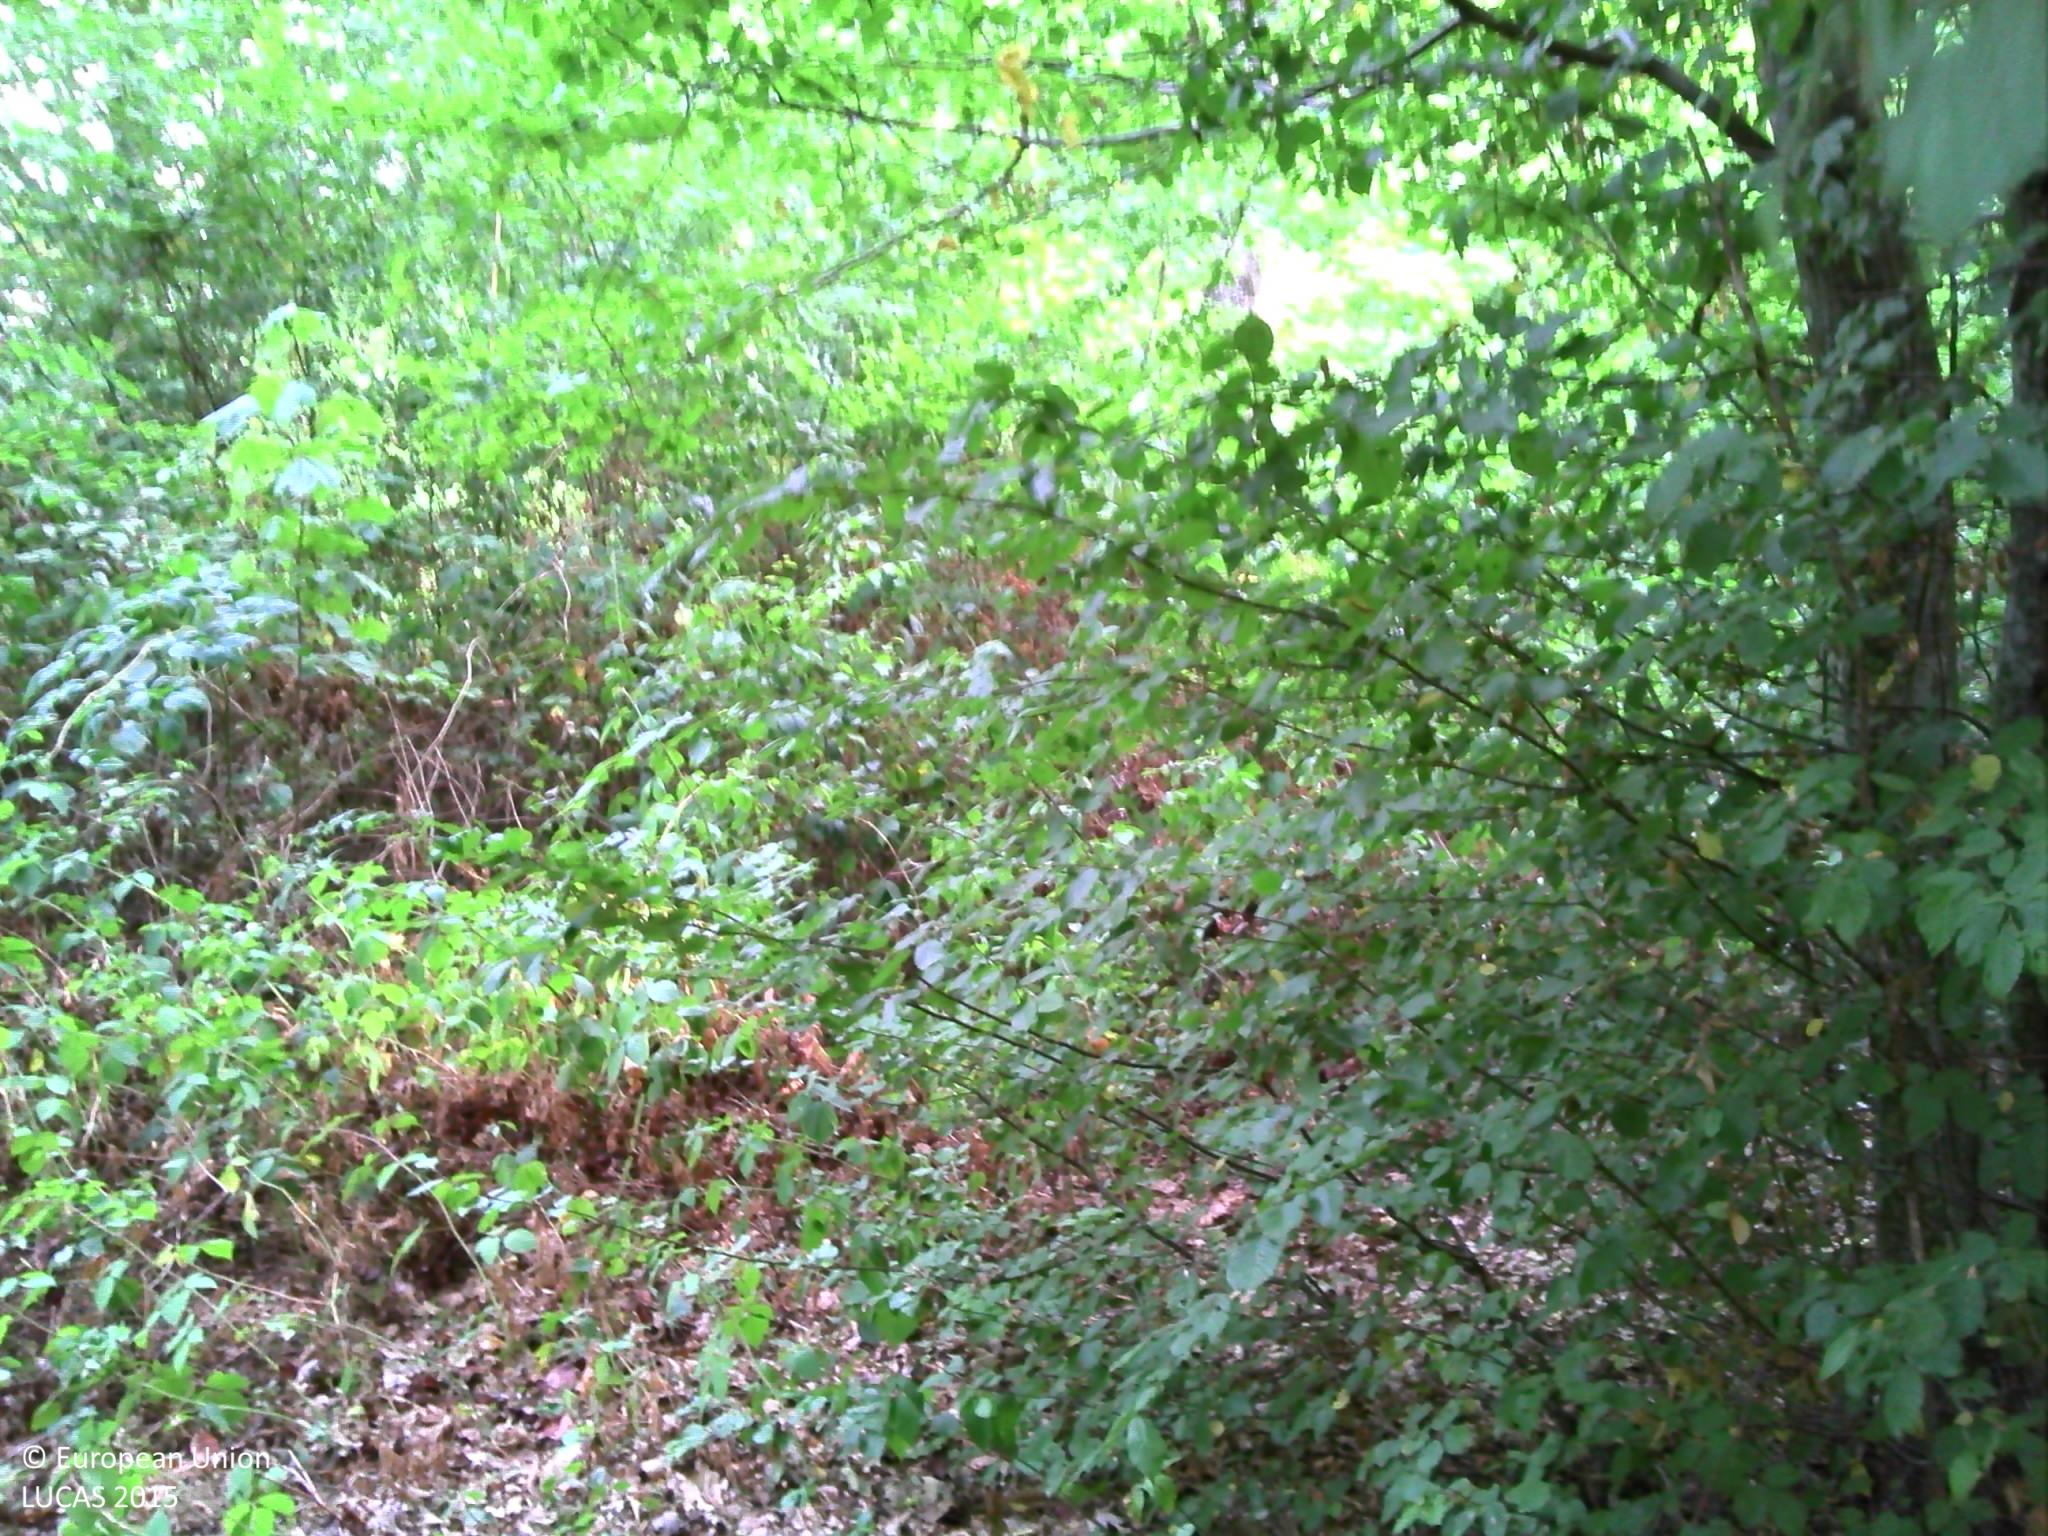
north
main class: Woodland
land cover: Broadleaved woodland
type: mesophytic deciduous forest
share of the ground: > 75 %
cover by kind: broadleaved forest trees 90 %, herbaceous plants 5 %, lichens and mosses 5 %
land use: Forestry
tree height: > 5 m
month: July
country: FR
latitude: 47.9350
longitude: 3.0998
